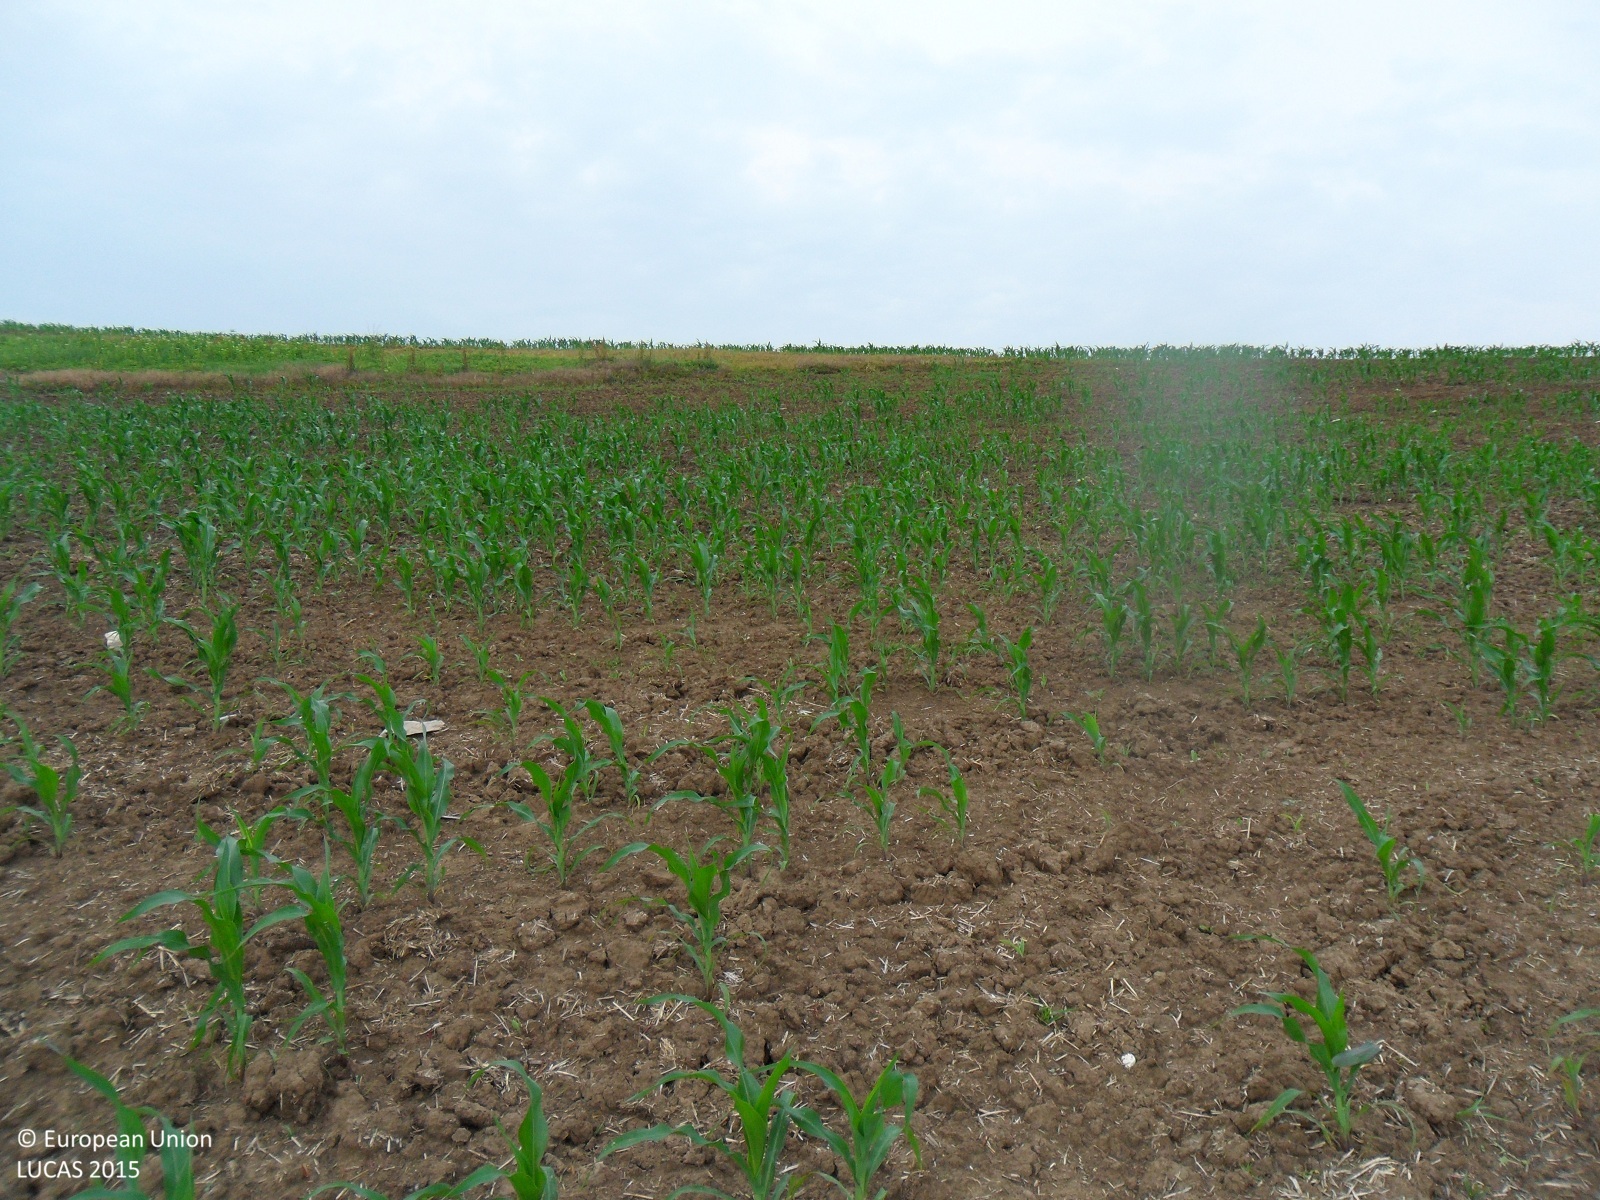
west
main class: Cropland
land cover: Maize
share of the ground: 25 - 50 %
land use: Agriculture (excluding fallow land and kitchen gardens)
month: June
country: BG
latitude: 43.7995
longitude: 26.7827
